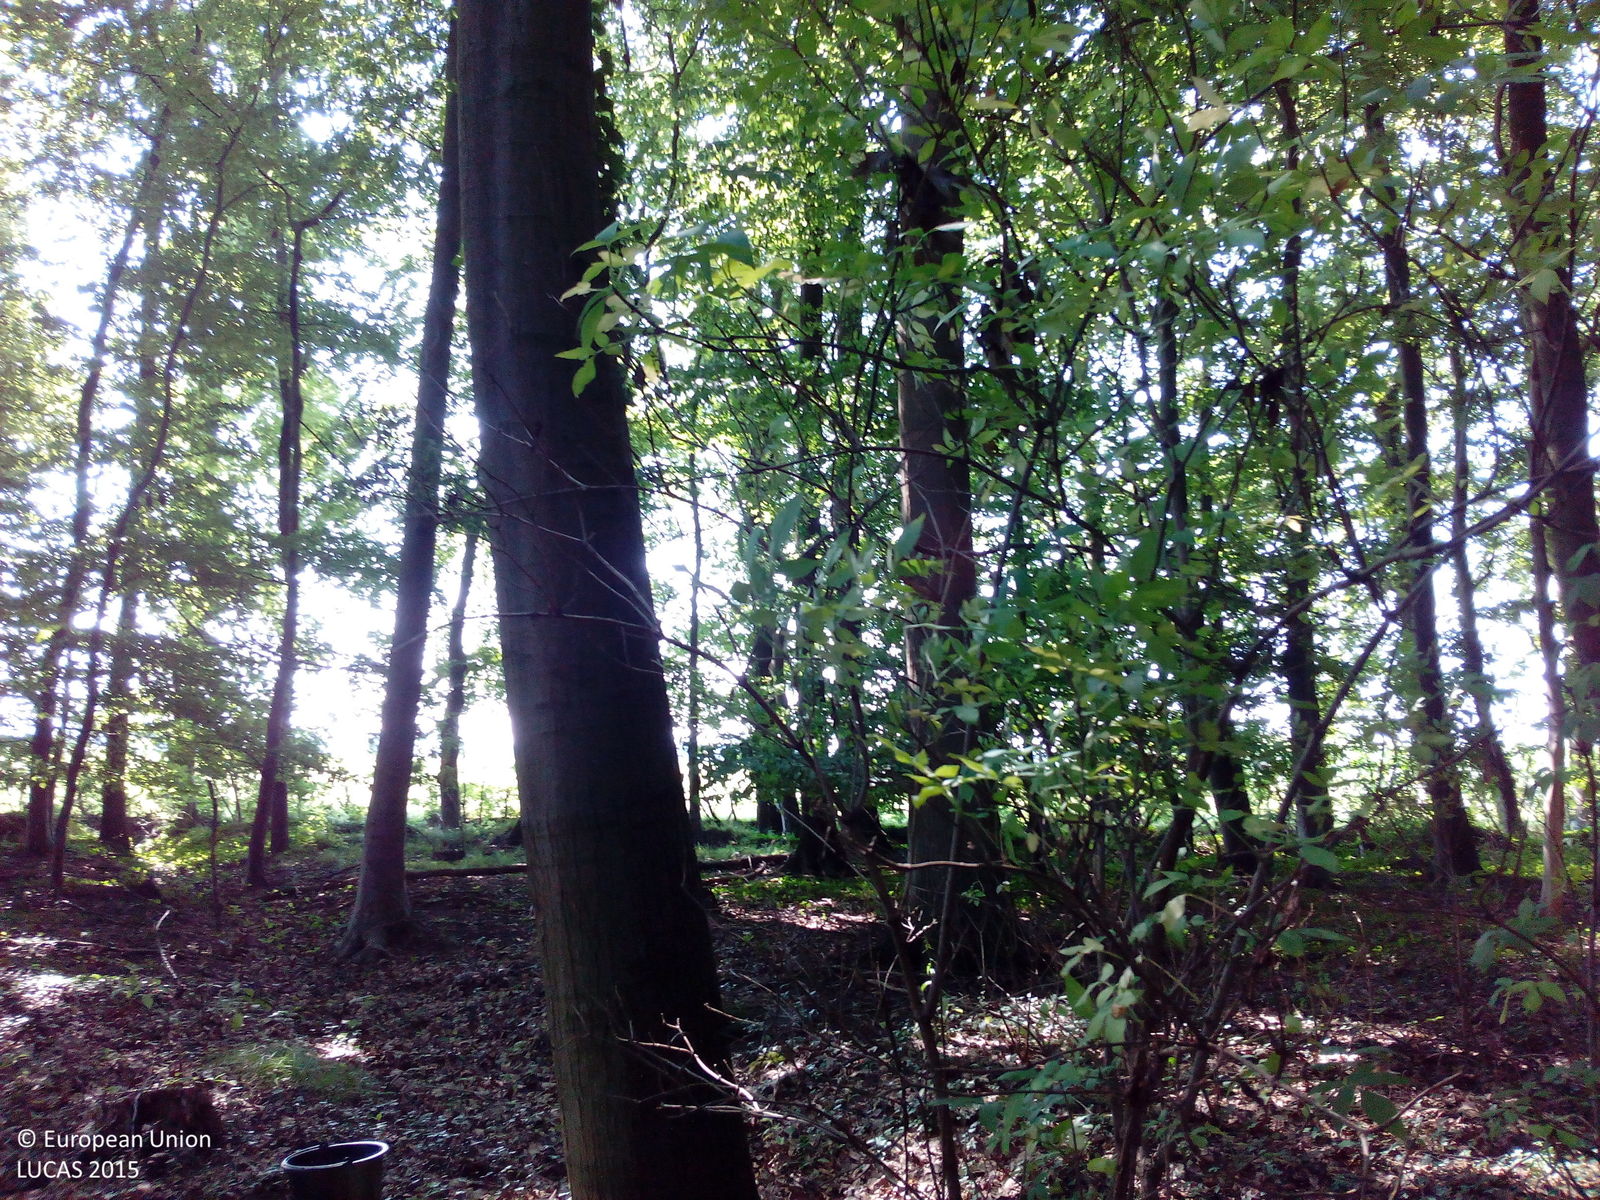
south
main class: Woodland
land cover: Broadleaved woodland
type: mesophytic deciduous forest
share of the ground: > 75 %
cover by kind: broadleaved forest trees 90 %, shrubs 5 %, herbaceous plants 5 %
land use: Forestry
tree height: > 5 m
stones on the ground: < 10 %
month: August
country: DE
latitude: 52.6474
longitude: 7.9460
